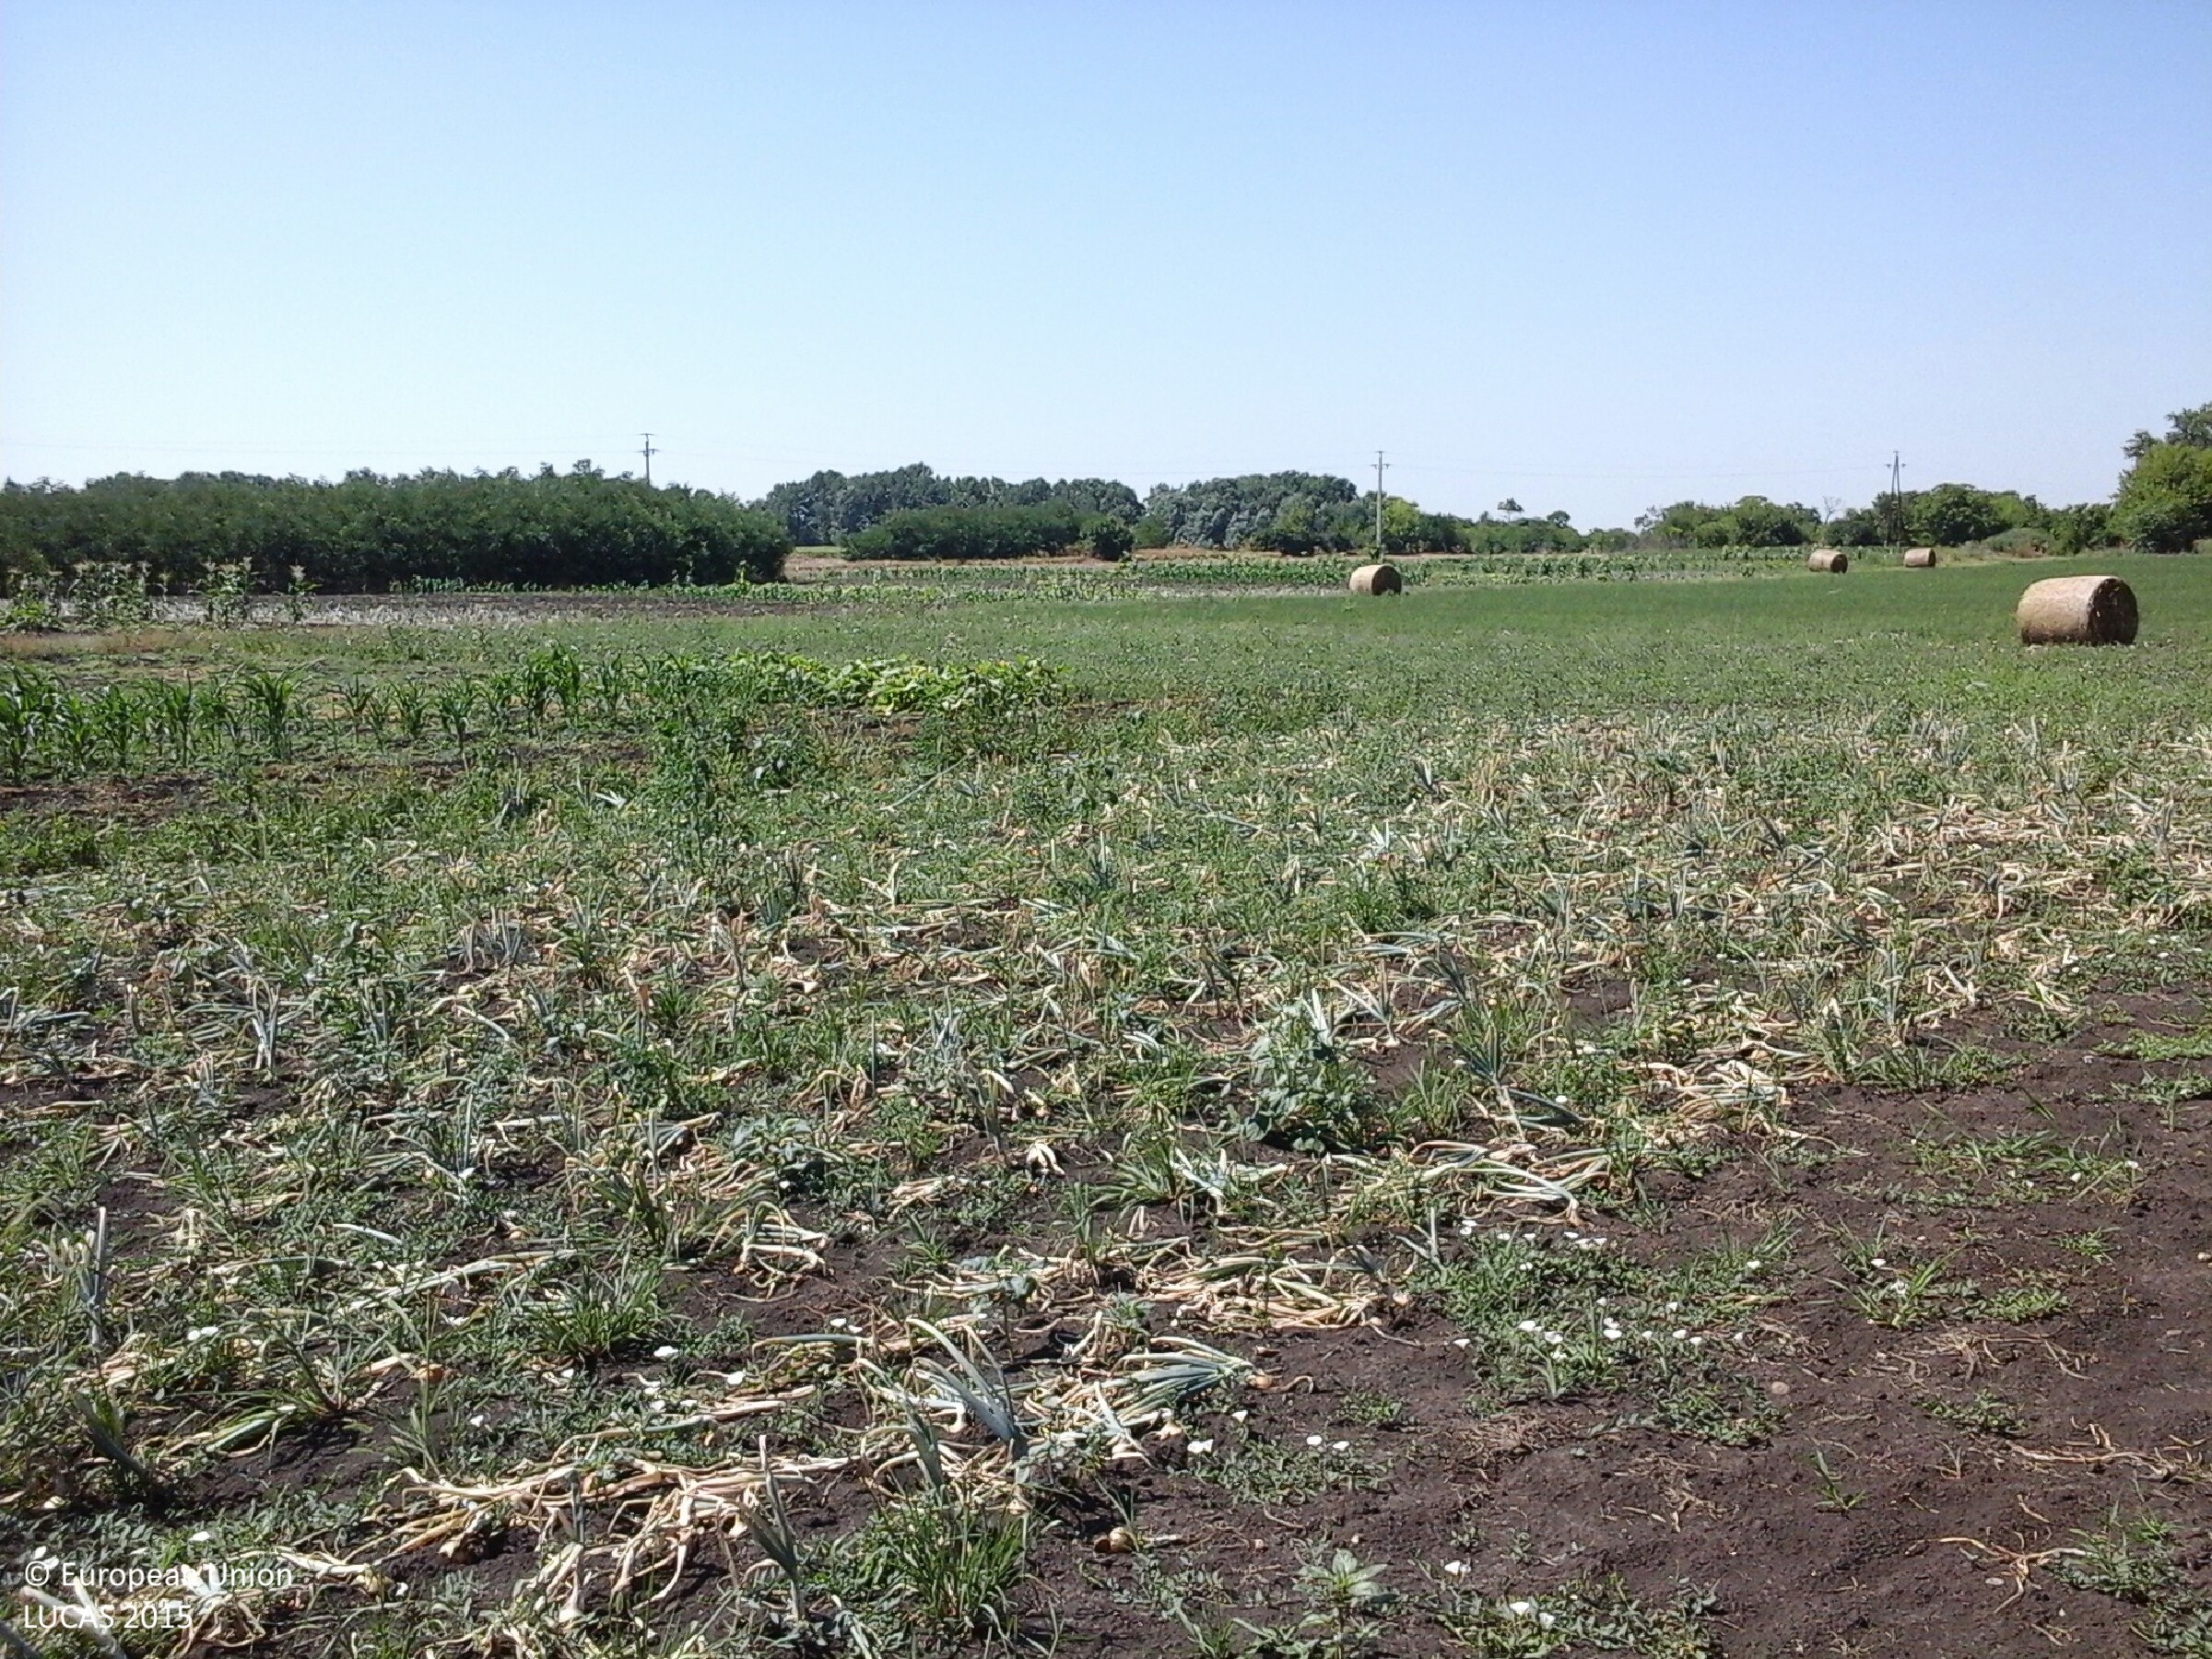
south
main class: Cropland
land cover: Other root crops
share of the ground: 25 - 50 %
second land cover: Spontaneously vegetated surfaces
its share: 25 - 50 %
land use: Agriculture (excluding fallow land and kitchen gardens)
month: July
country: HU
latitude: 47.6218
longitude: 20.5841
